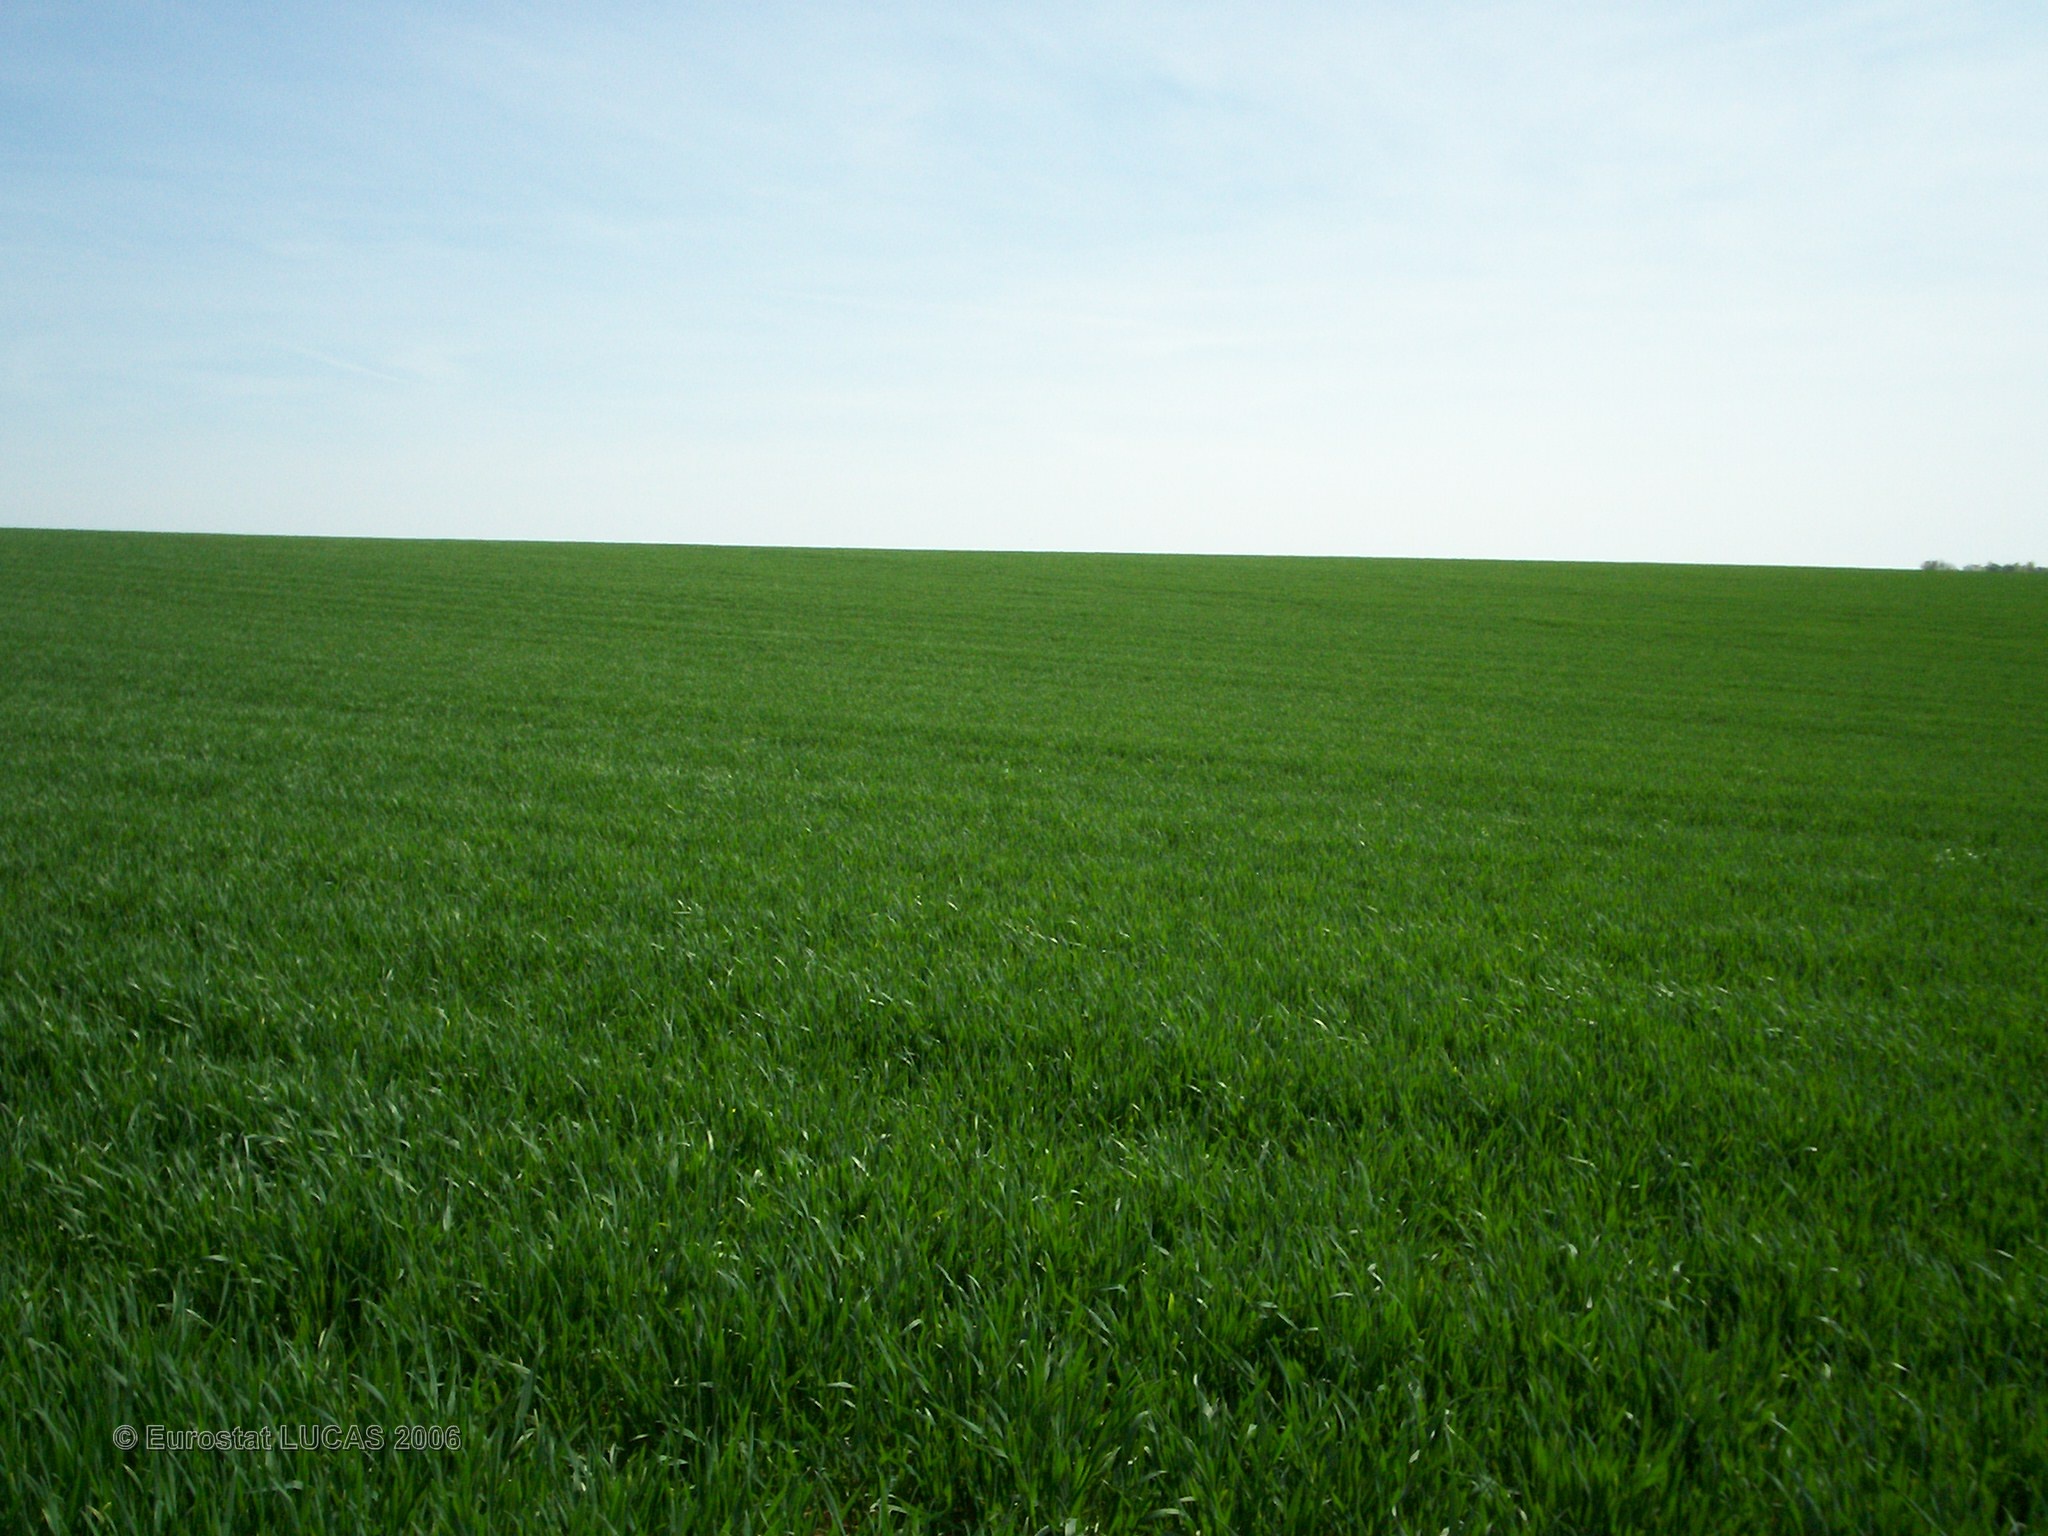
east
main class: Cropland
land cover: Common wheat
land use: Agriculture (excluding fallow land and kitchen gardens)
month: May
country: FR
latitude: 47.8884
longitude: 3.8310
